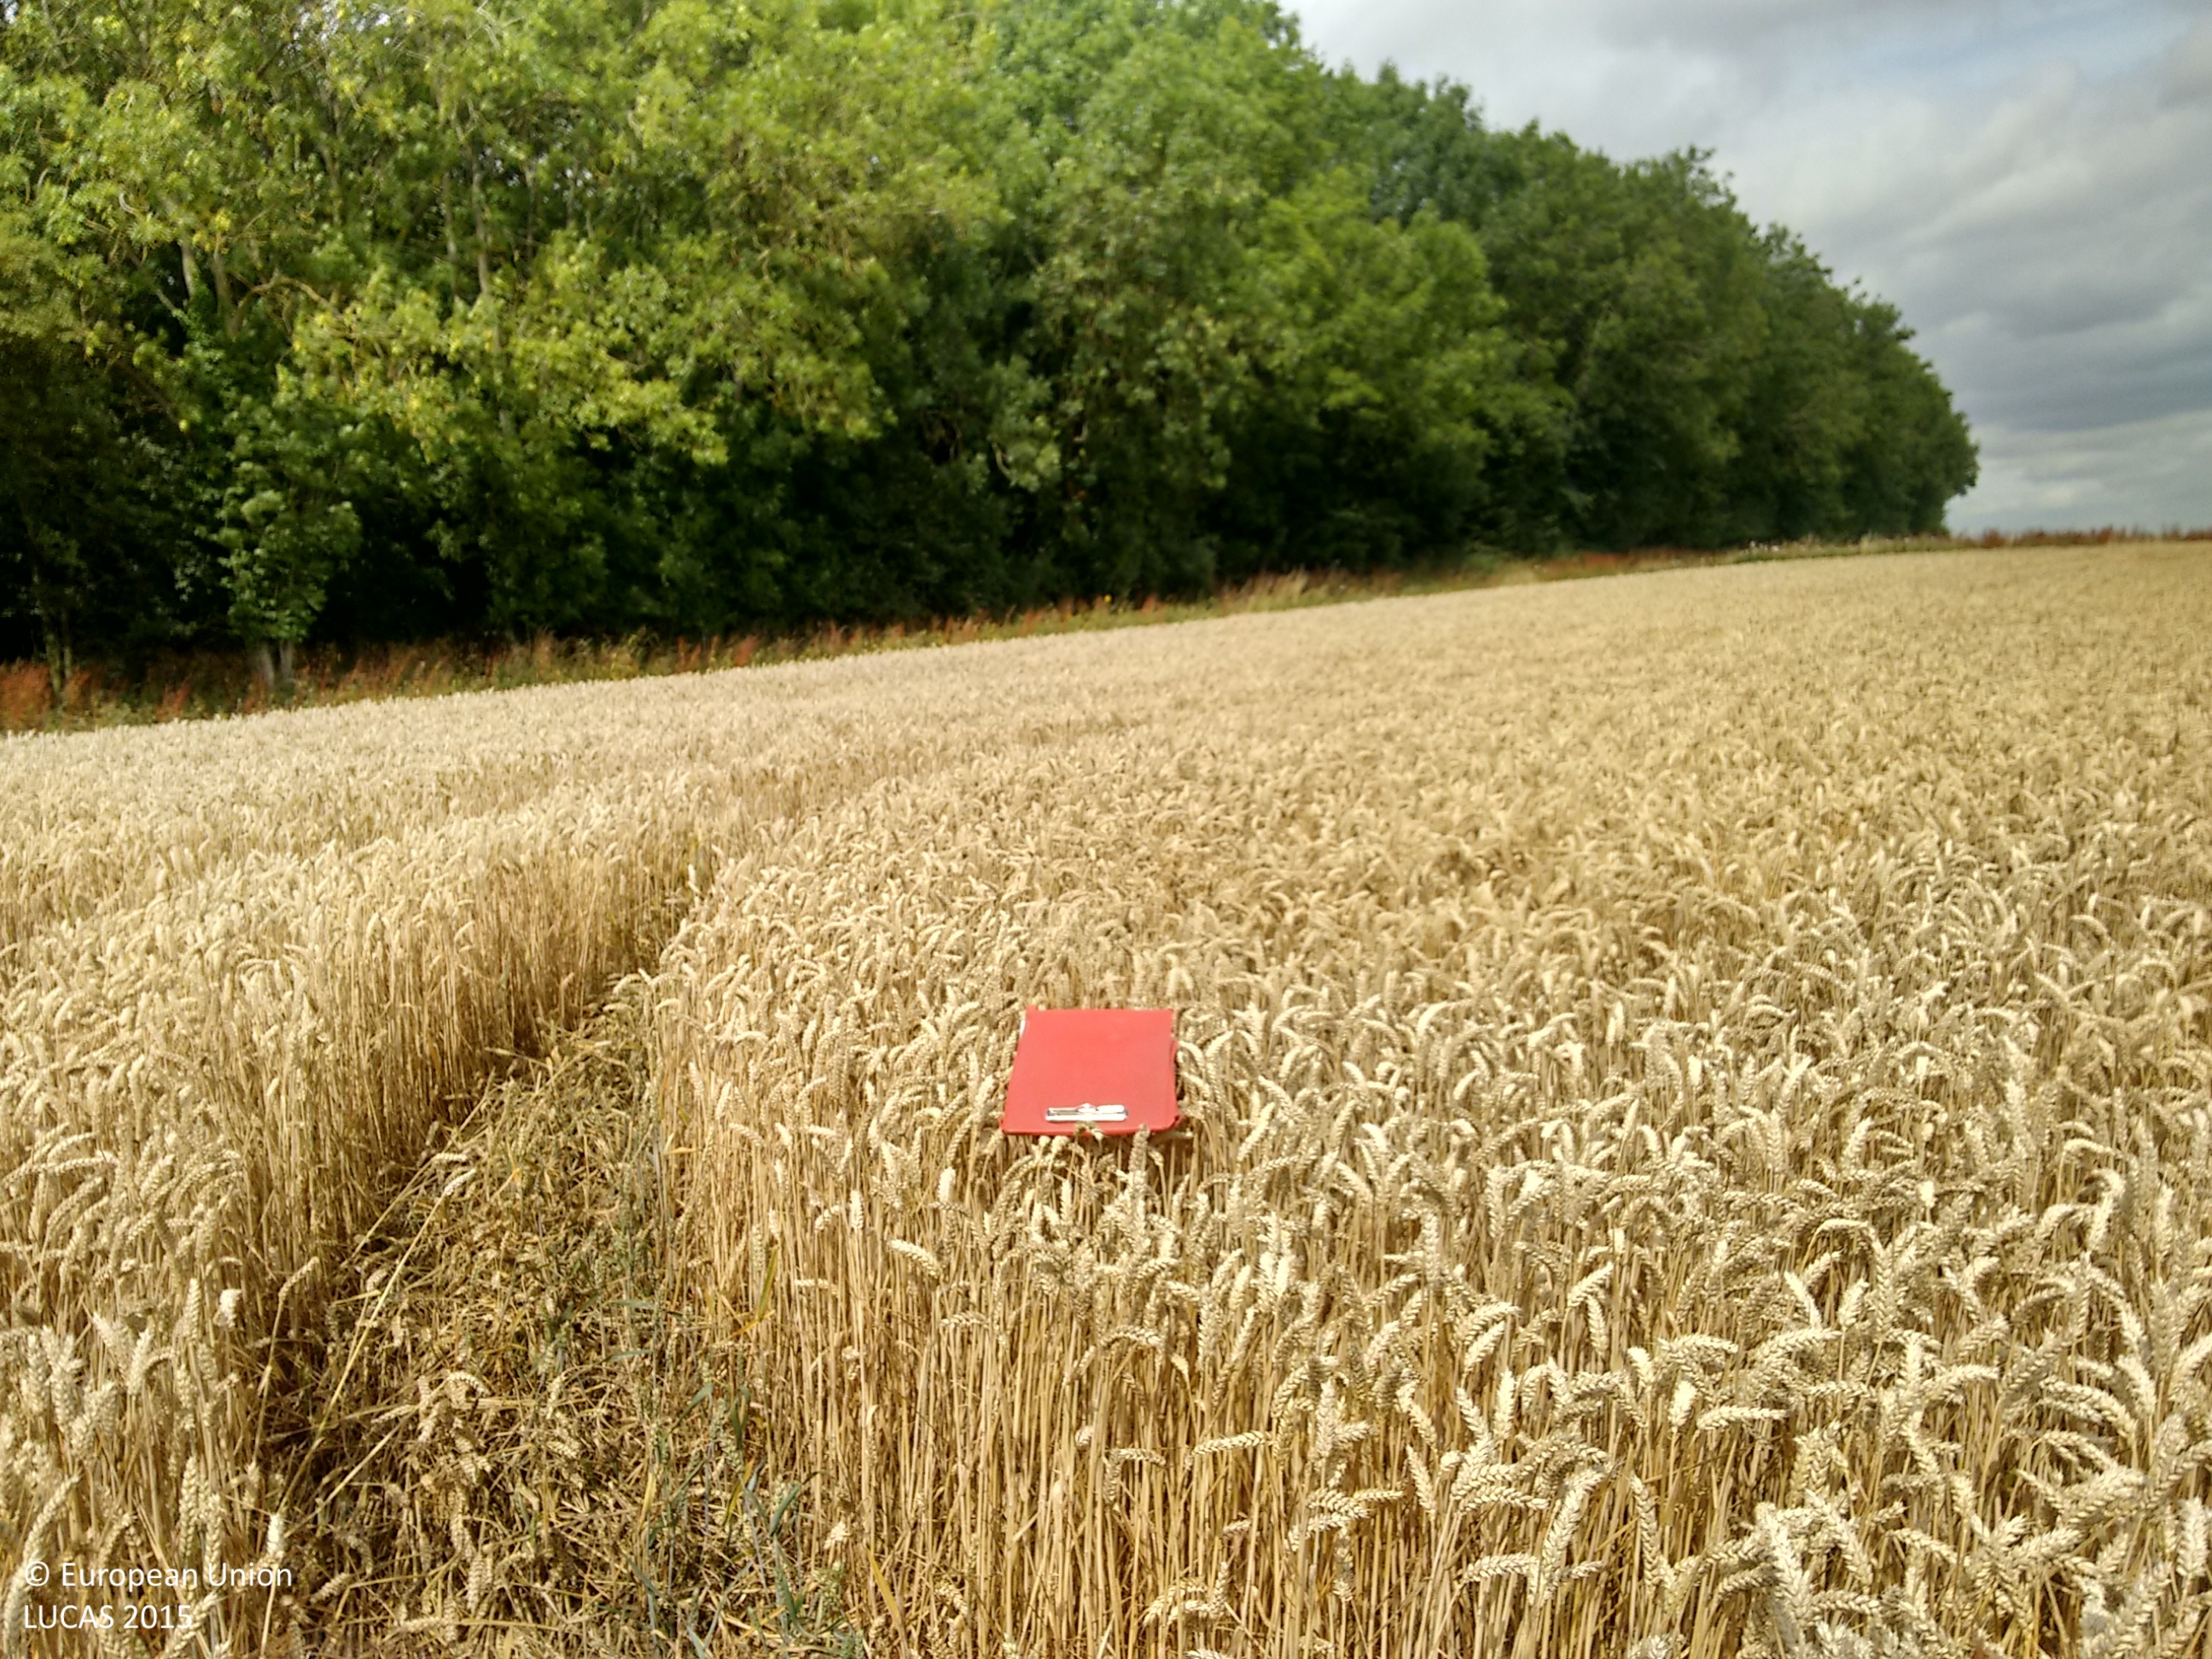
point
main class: Cropland
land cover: Common wheat
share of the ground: > 75 %
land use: Agriculture (excluding fallow land and kitchen gardens)
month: August
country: GB
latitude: 51.9832
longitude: 0.3464
